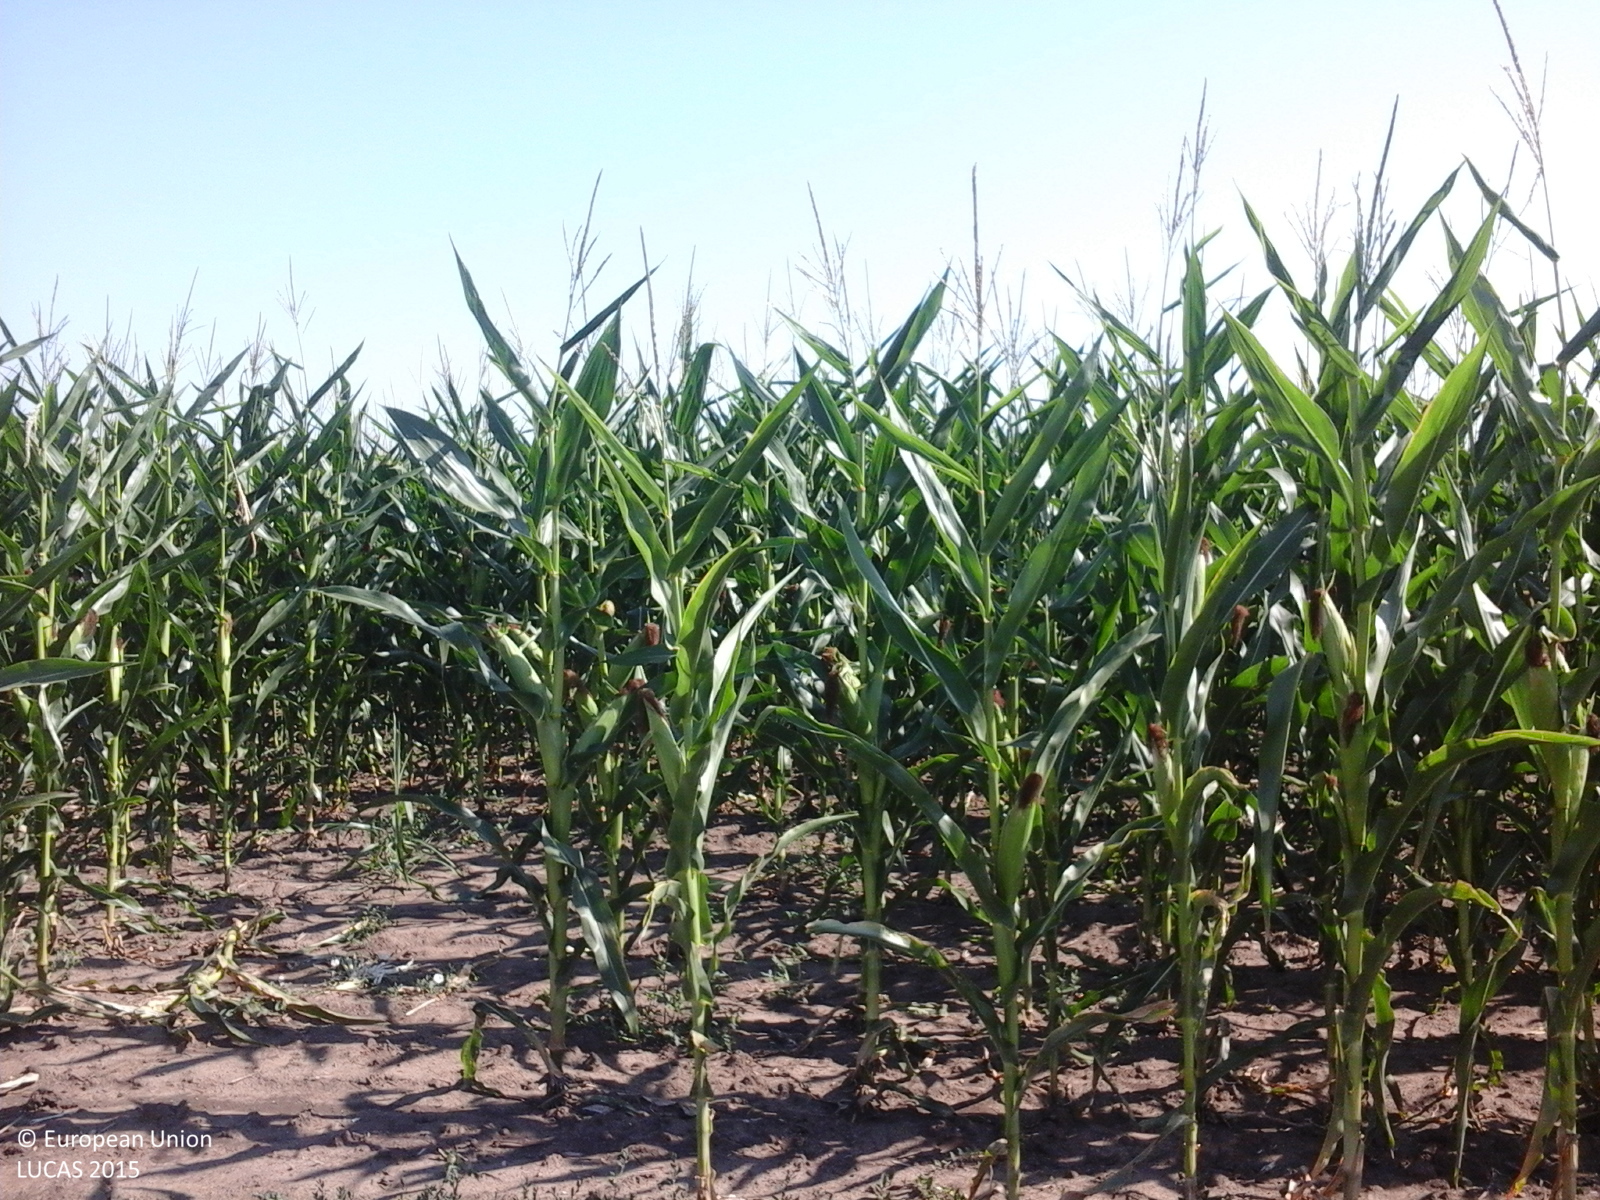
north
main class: Cropland
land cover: Maize
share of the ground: > 75 %
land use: Agriculture (excluding fallow land and kitchen gardens)
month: July
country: RO
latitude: 44.7585
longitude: 27.1004
